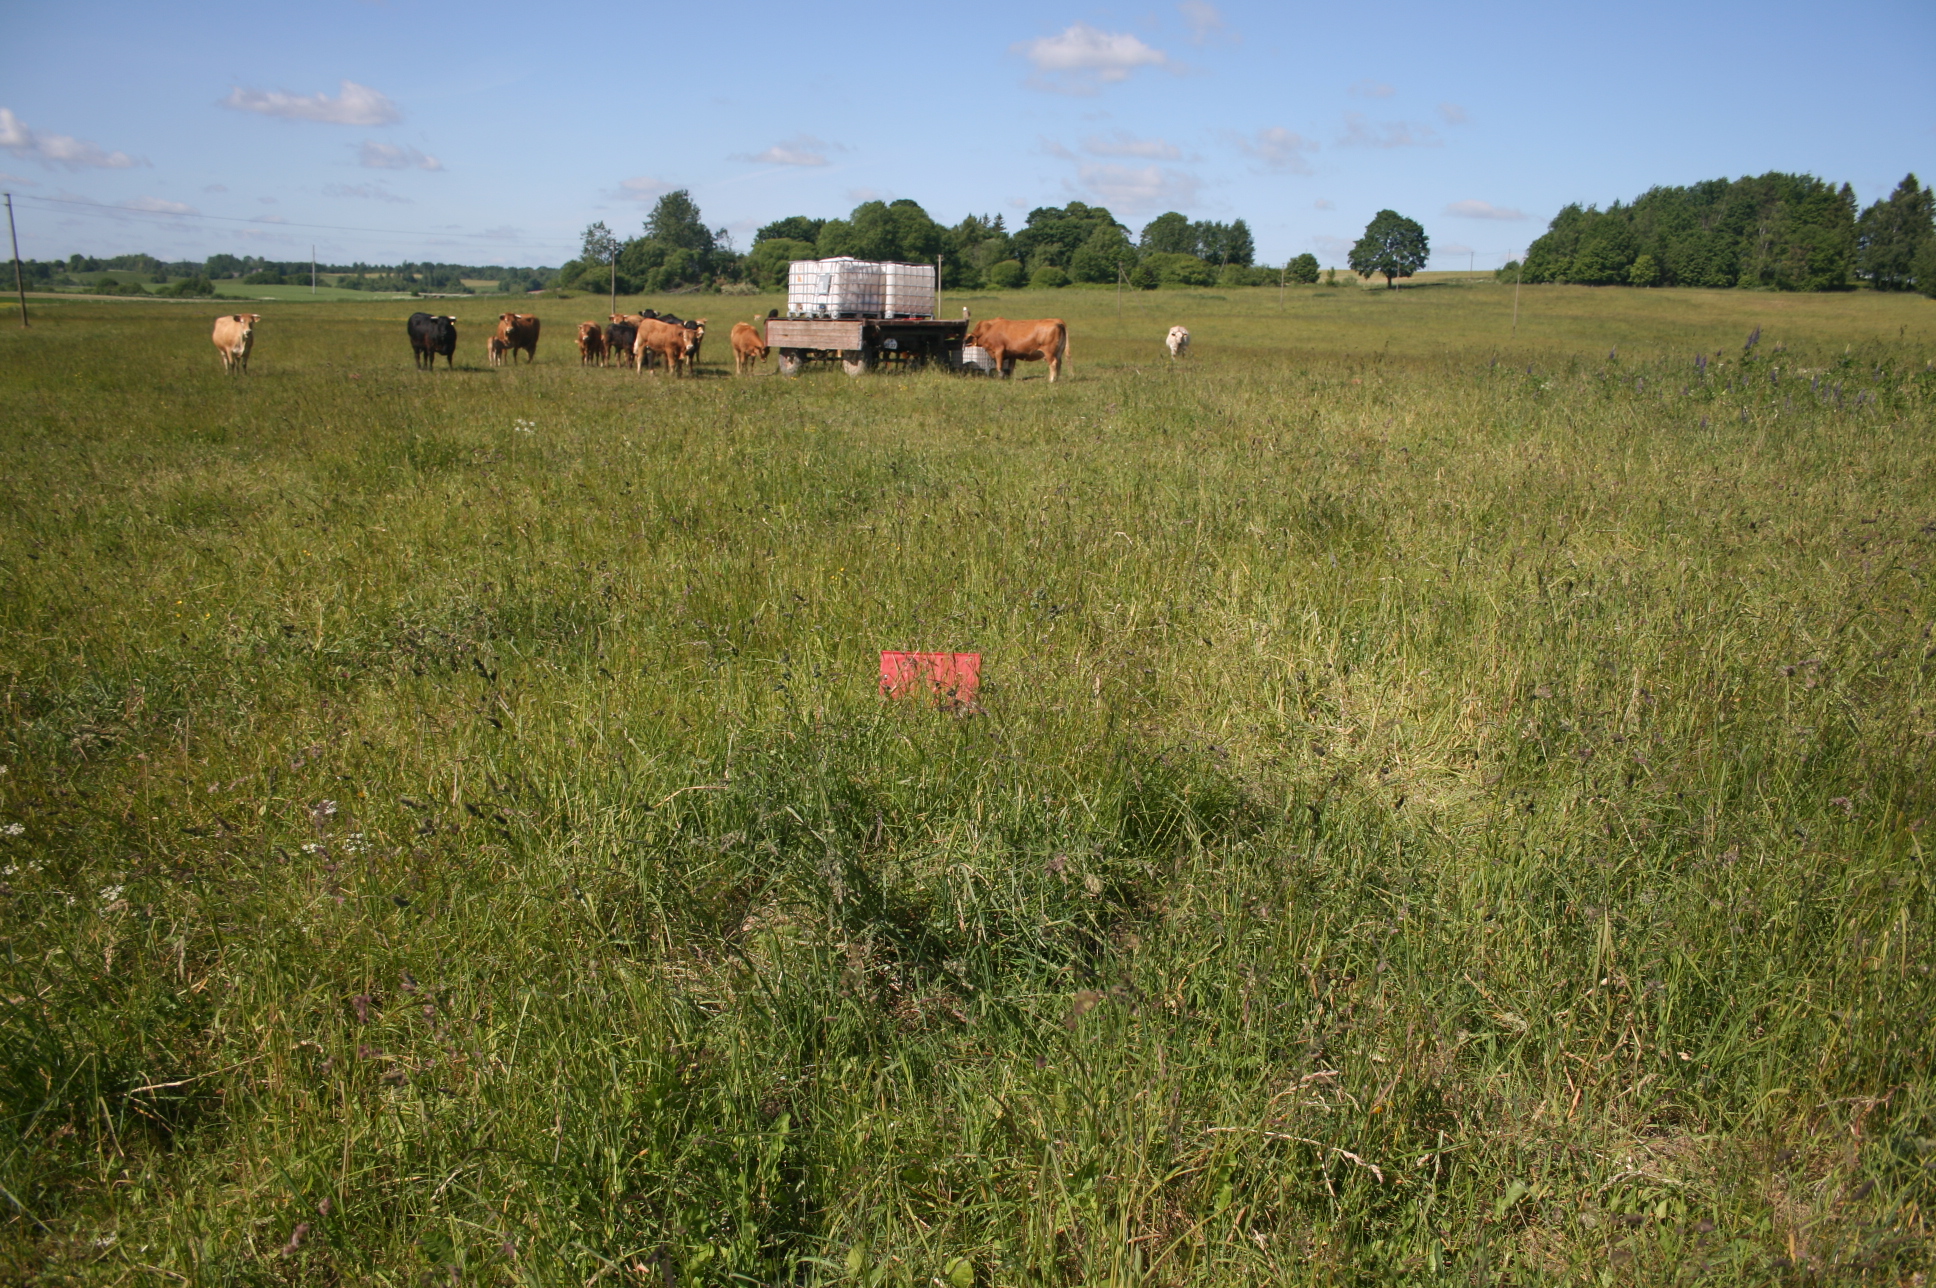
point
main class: Grassland
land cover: Grassland without tree/shrub cover
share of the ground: > 75 %
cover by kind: herbaceous plants 100 %
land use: Agriculture (excluding fallow land and kitchen gardens)
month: June
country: LT
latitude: 55.9420
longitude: 22.2719
